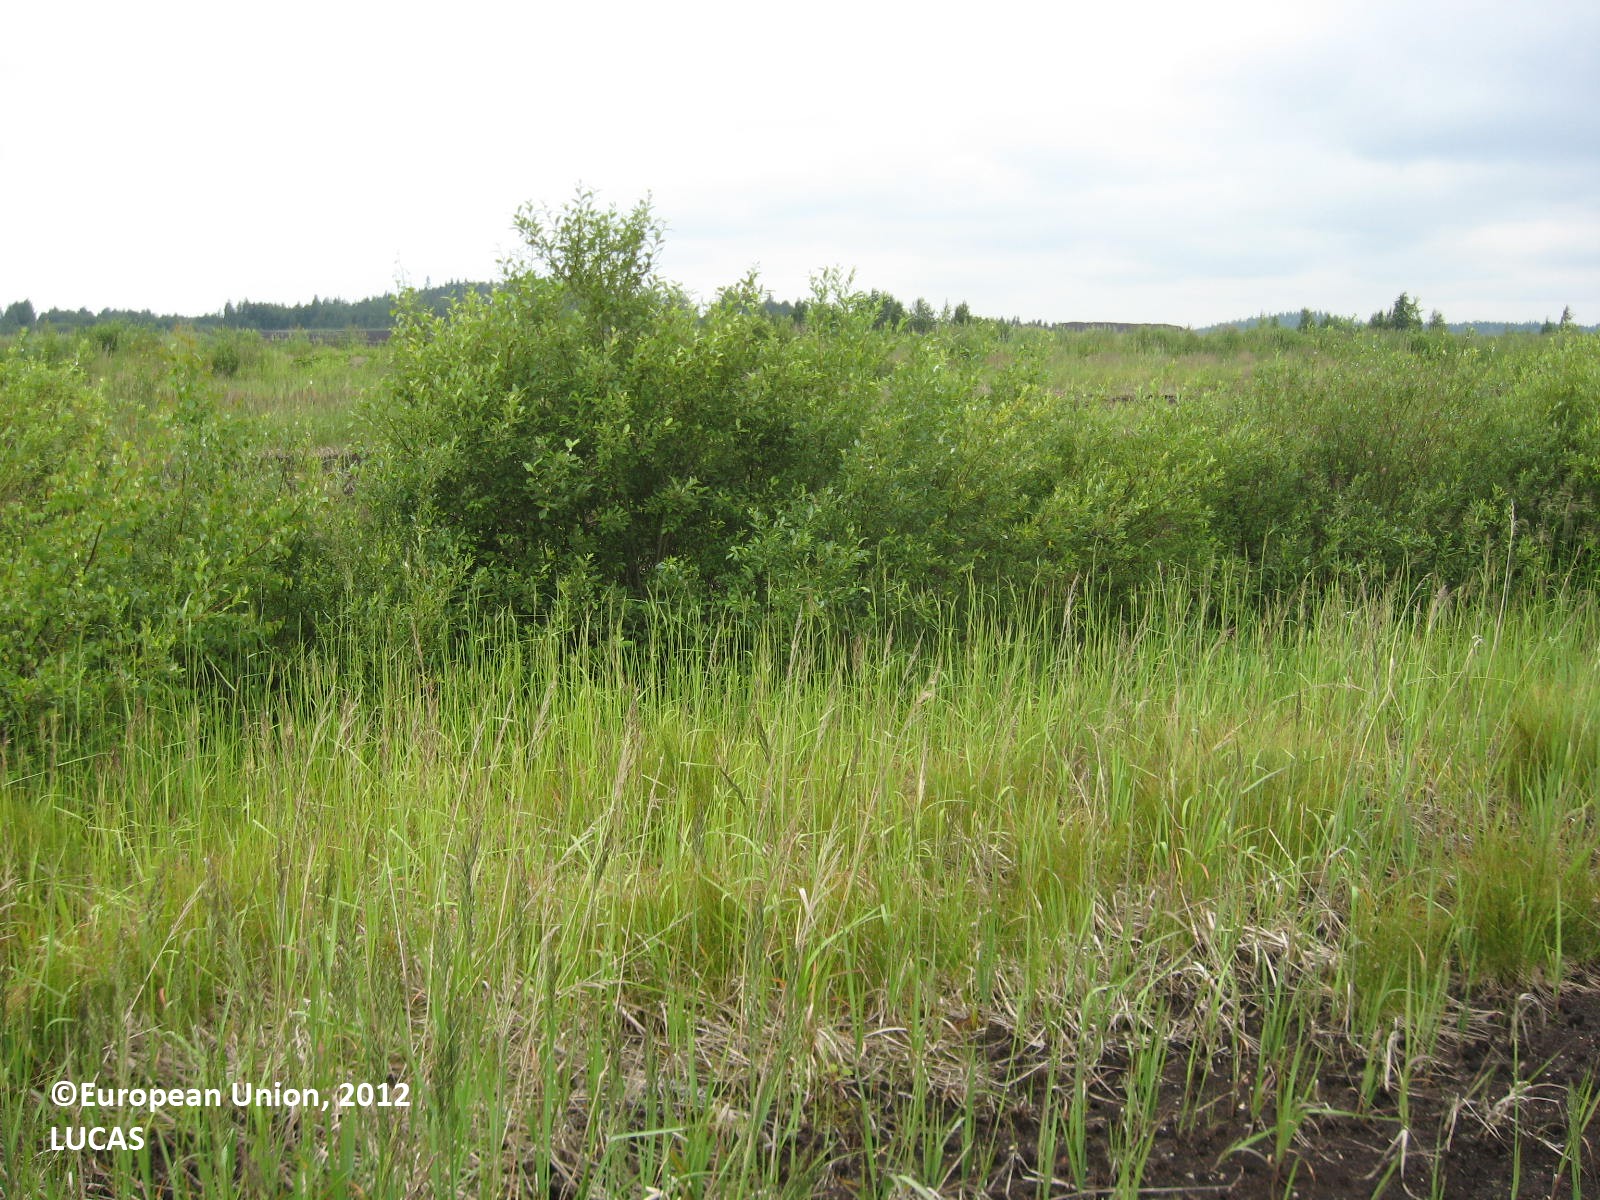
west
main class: Grassland
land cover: Spontaneously vegetated surfaces
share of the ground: > 75 %
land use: Abandoned areas
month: July
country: FI
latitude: 62.4679
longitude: 22.5646
